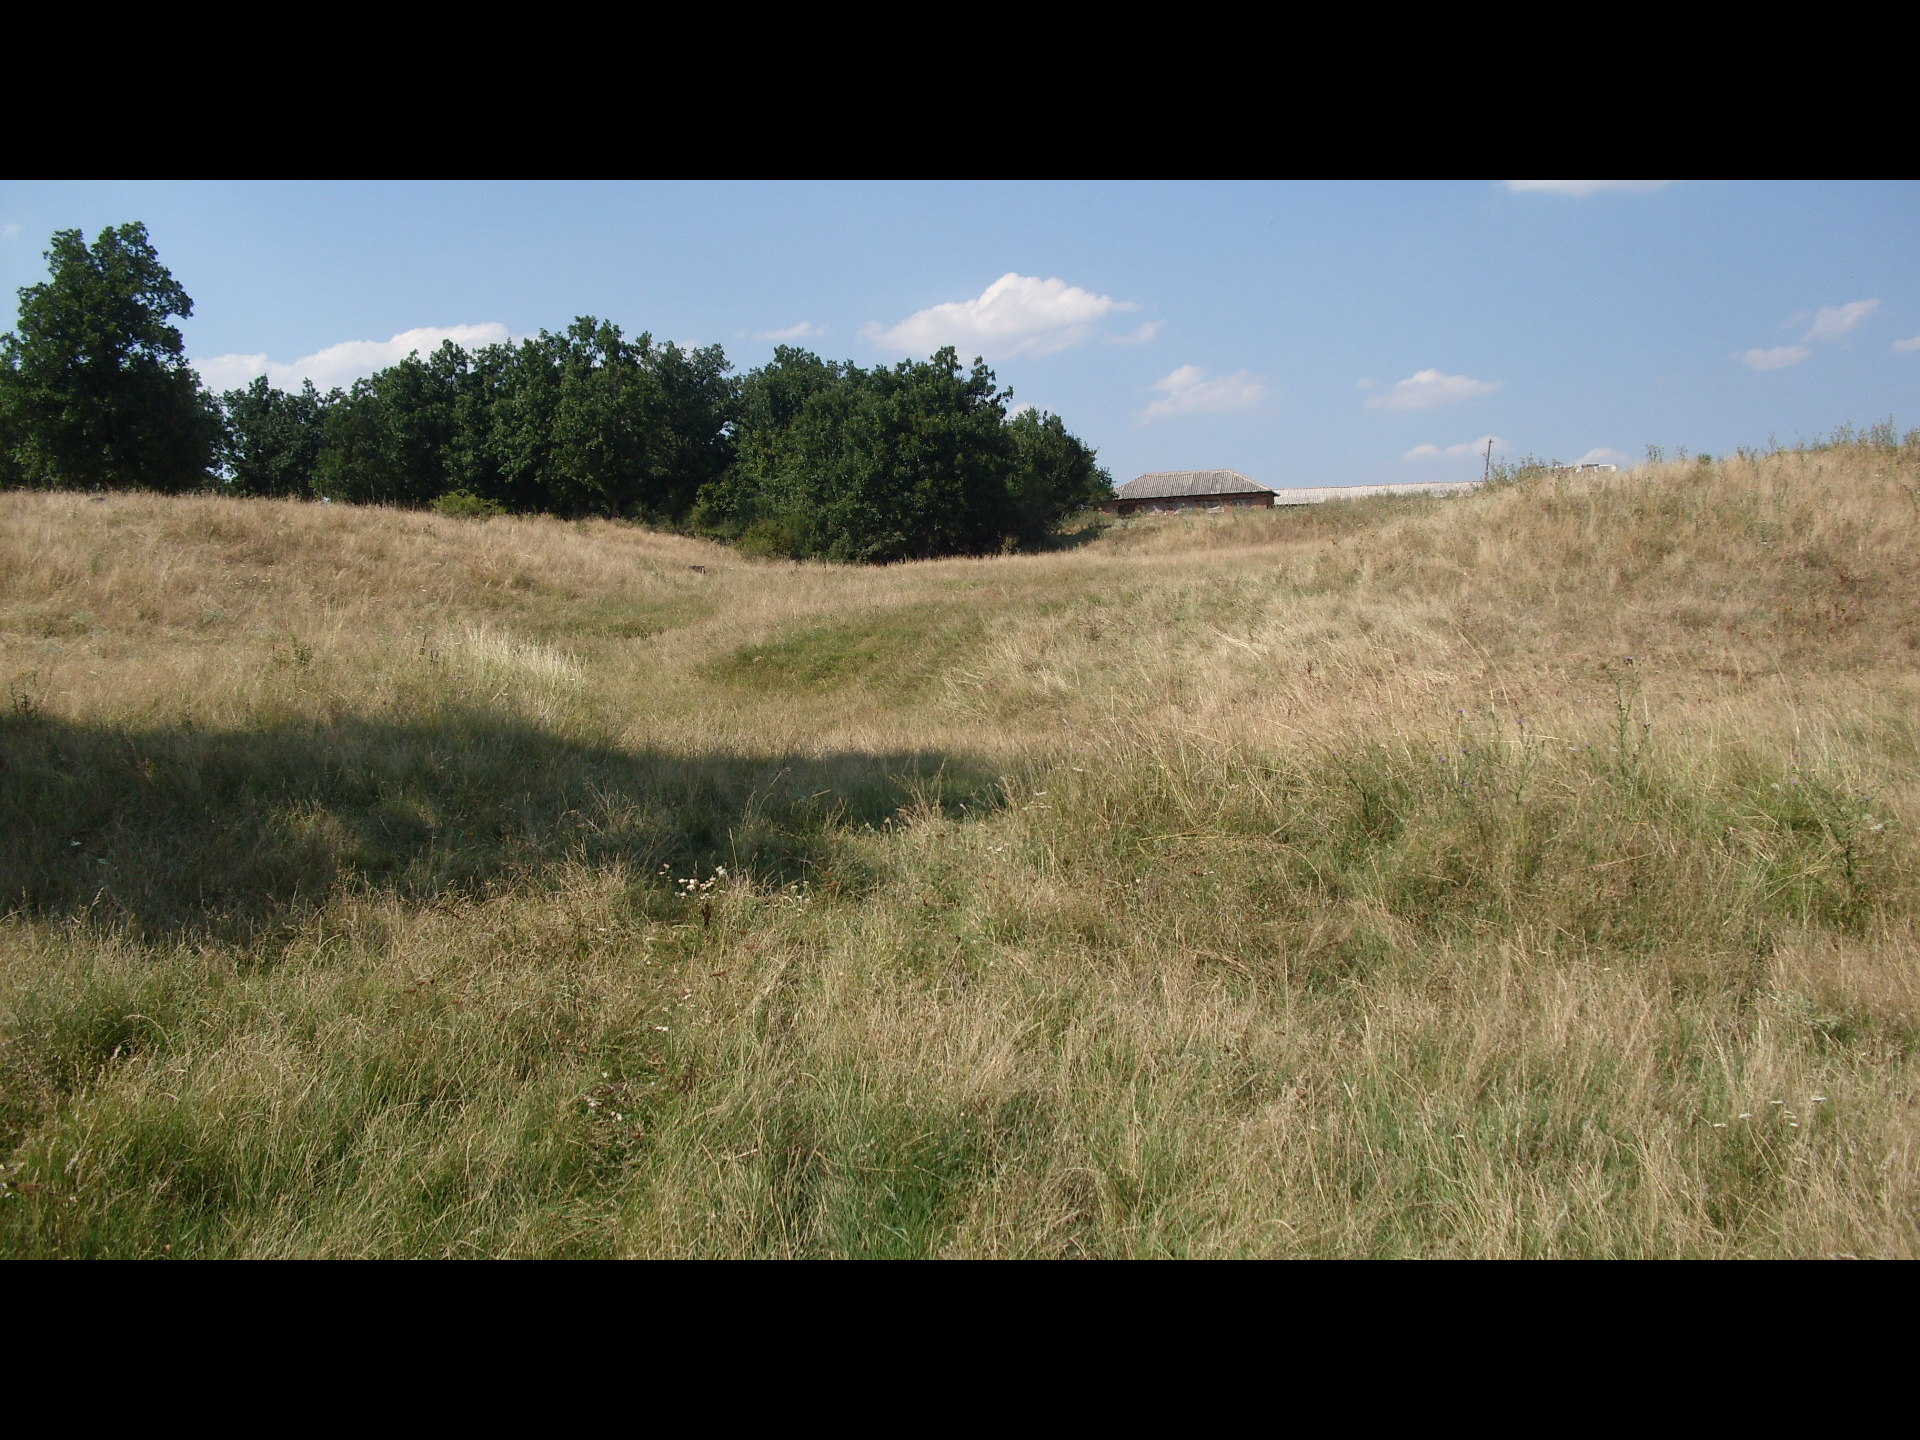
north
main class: Grassland
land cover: Grassland without tree/shrub cover
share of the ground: > 75 %
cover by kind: herbaceous plants 100 %
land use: Agriculture (excluding fallow land and kitchen gardens)
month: August
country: BG
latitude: 43.5476
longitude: 22.9965
